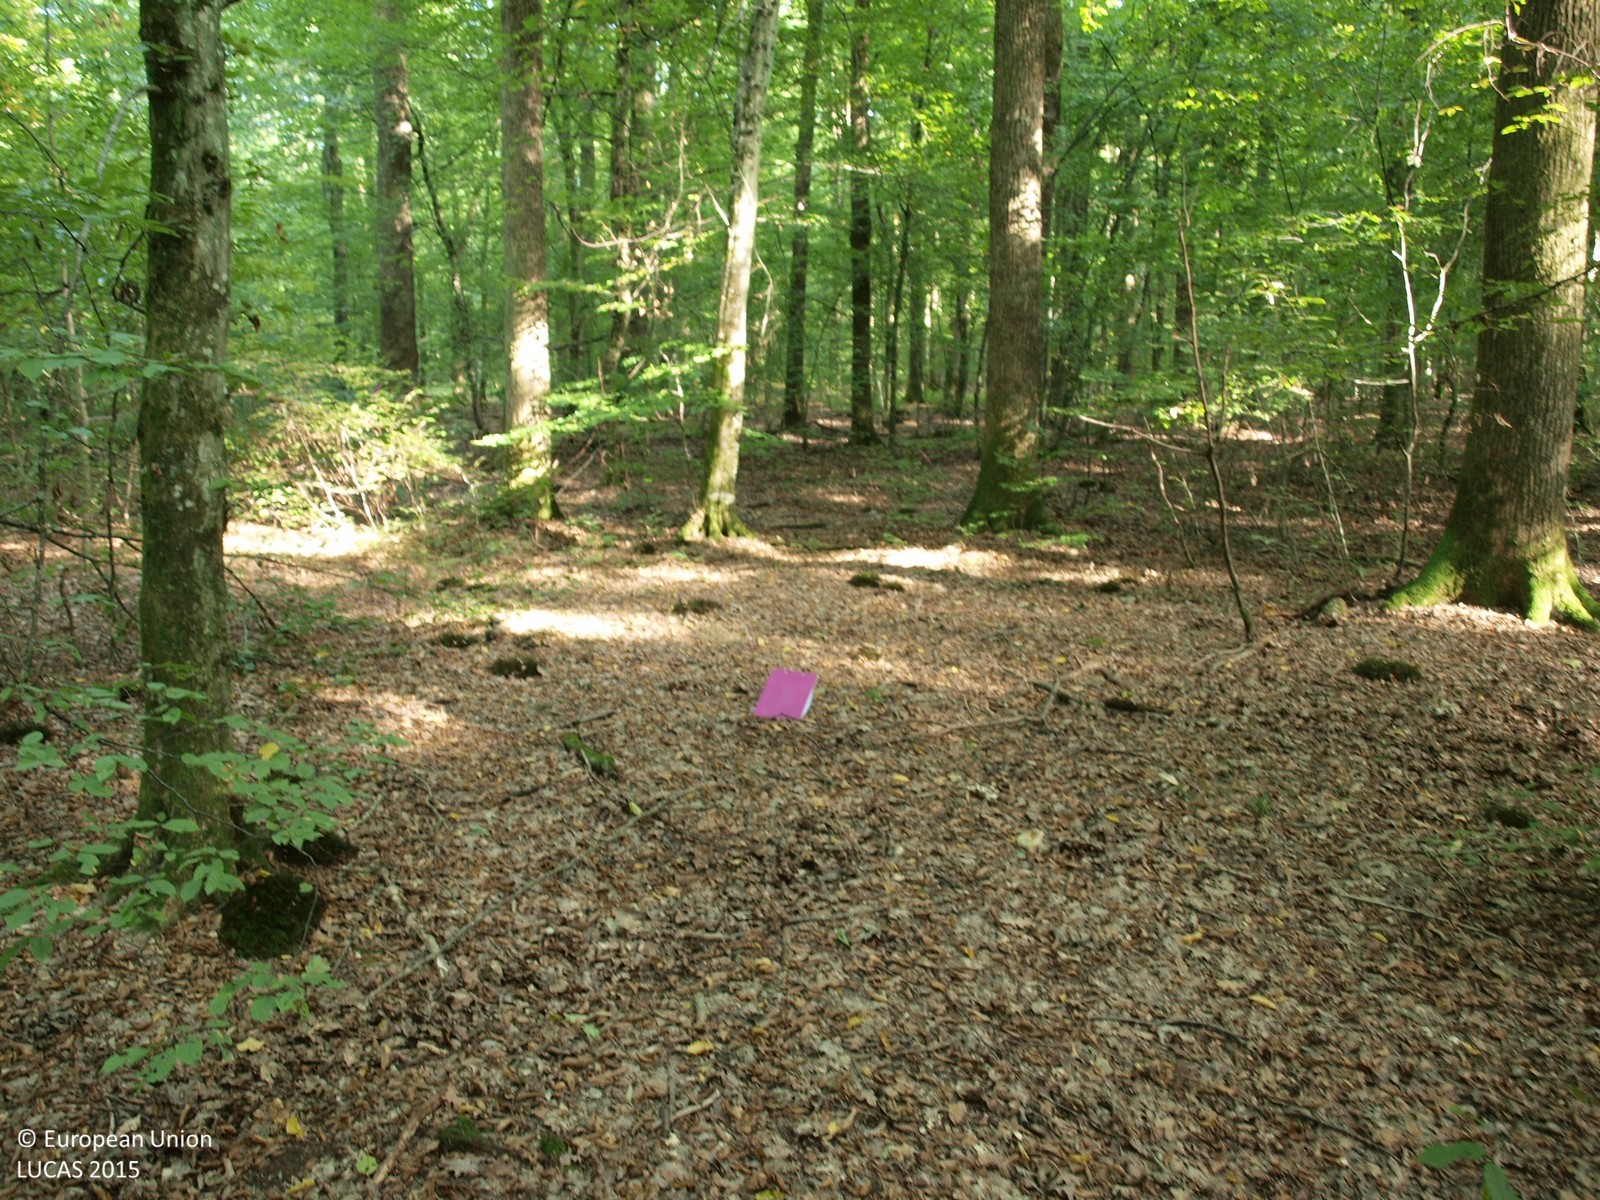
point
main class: Woodland
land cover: Broadleaved woodland
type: mesophytic deciduous forest
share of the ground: > 75 %
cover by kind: broadleaved forest trees 100 %
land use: Forestry
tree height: > 5 m
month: September
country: HR
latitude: 45.6177
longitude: 16.0892
